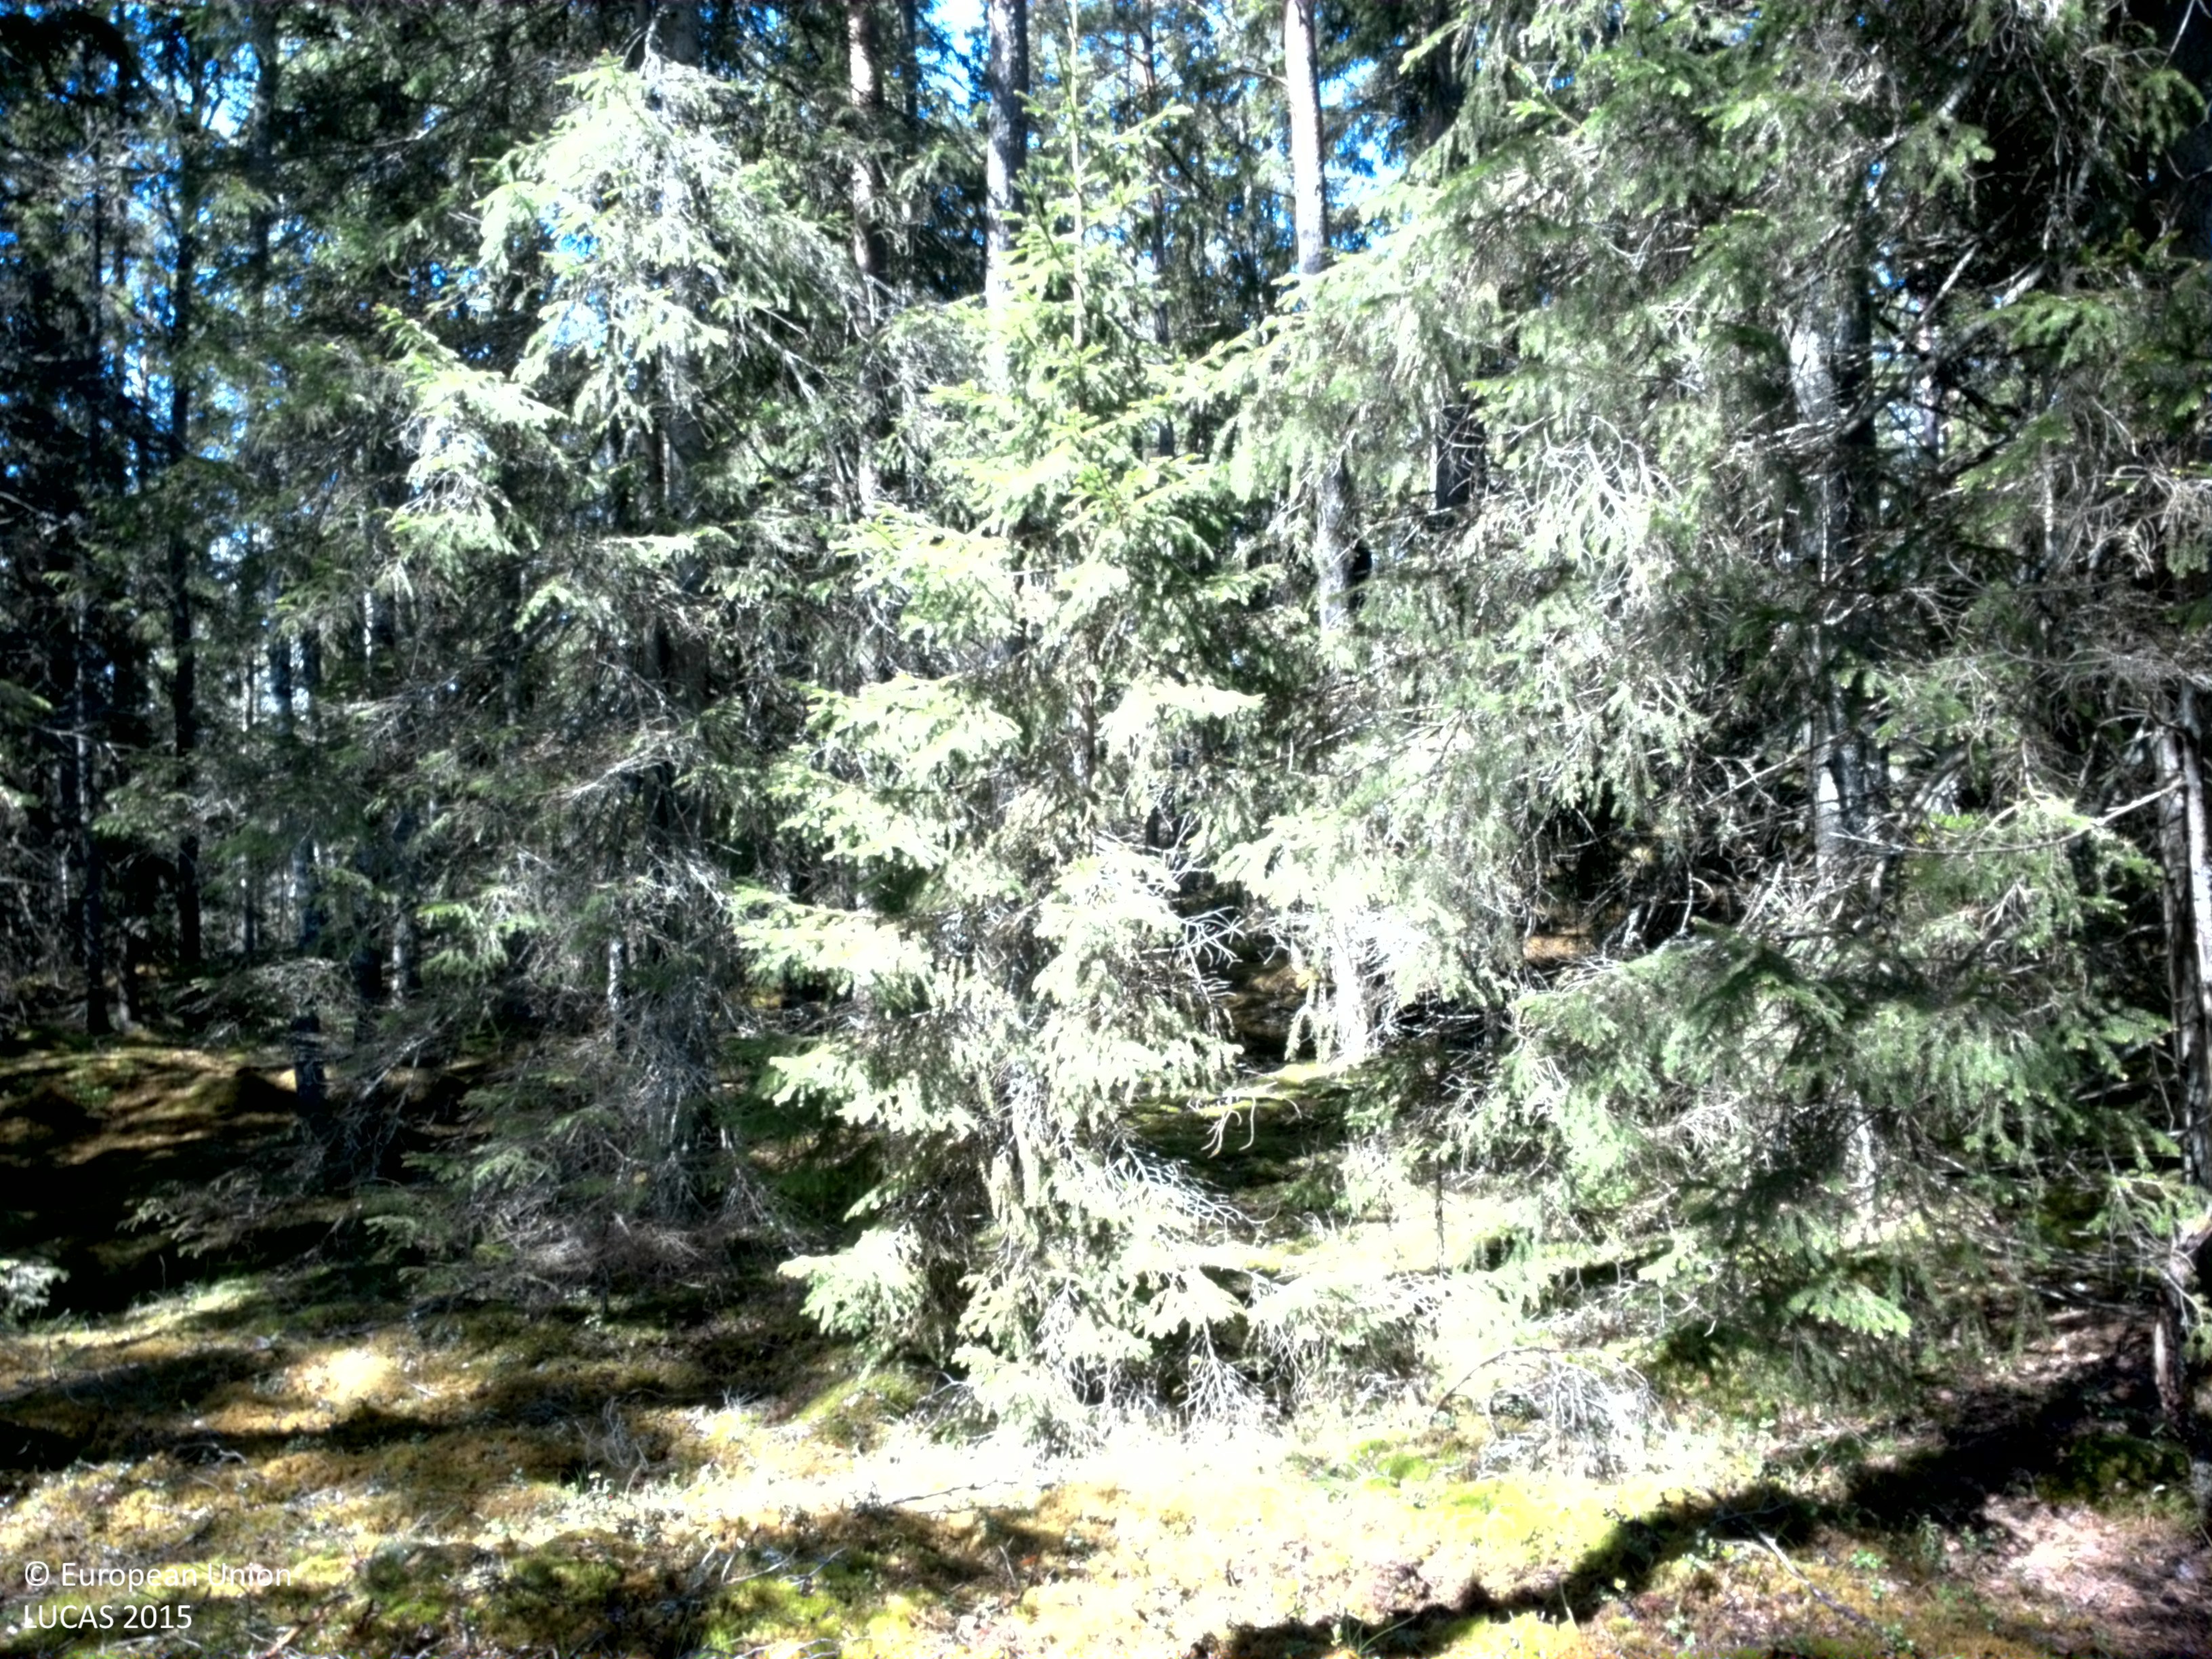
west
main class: Woodland
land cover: Spruce dominated coniferous woodland
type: boreal forest
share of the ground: 50 - 75 %
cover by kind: coniferous forest trees 45 %, lichens and mosses 30 %, broadleaved forest trees 10 %, shrubs 10 %, herbaceous plants 5 %
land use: Forestry
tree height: > 5 m
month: May
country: SE
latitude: 56.8977
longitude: 15.5310
